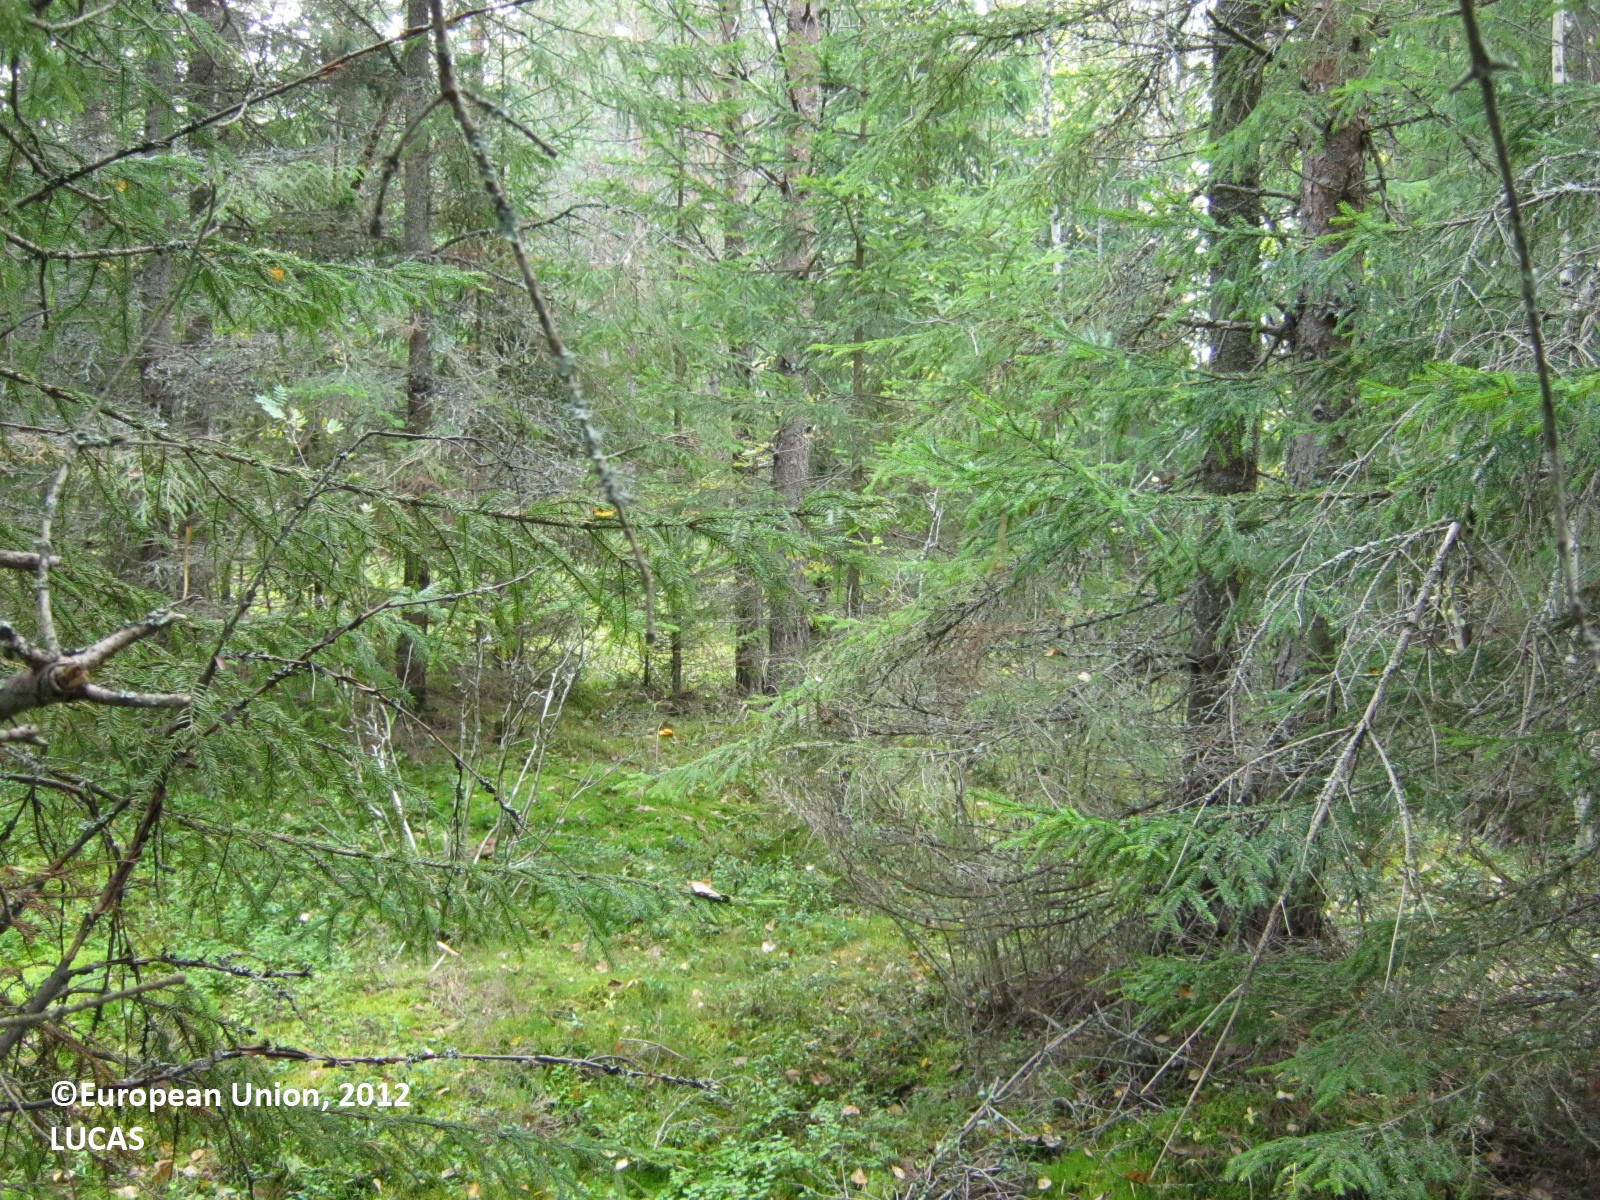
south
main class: Woodland
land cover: Other coniferous woodland
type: boreal forest
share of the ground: > 75 %
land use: Forestry
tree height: > 5 m
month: September
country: FI
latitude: 60.7108
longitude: 27.7290
